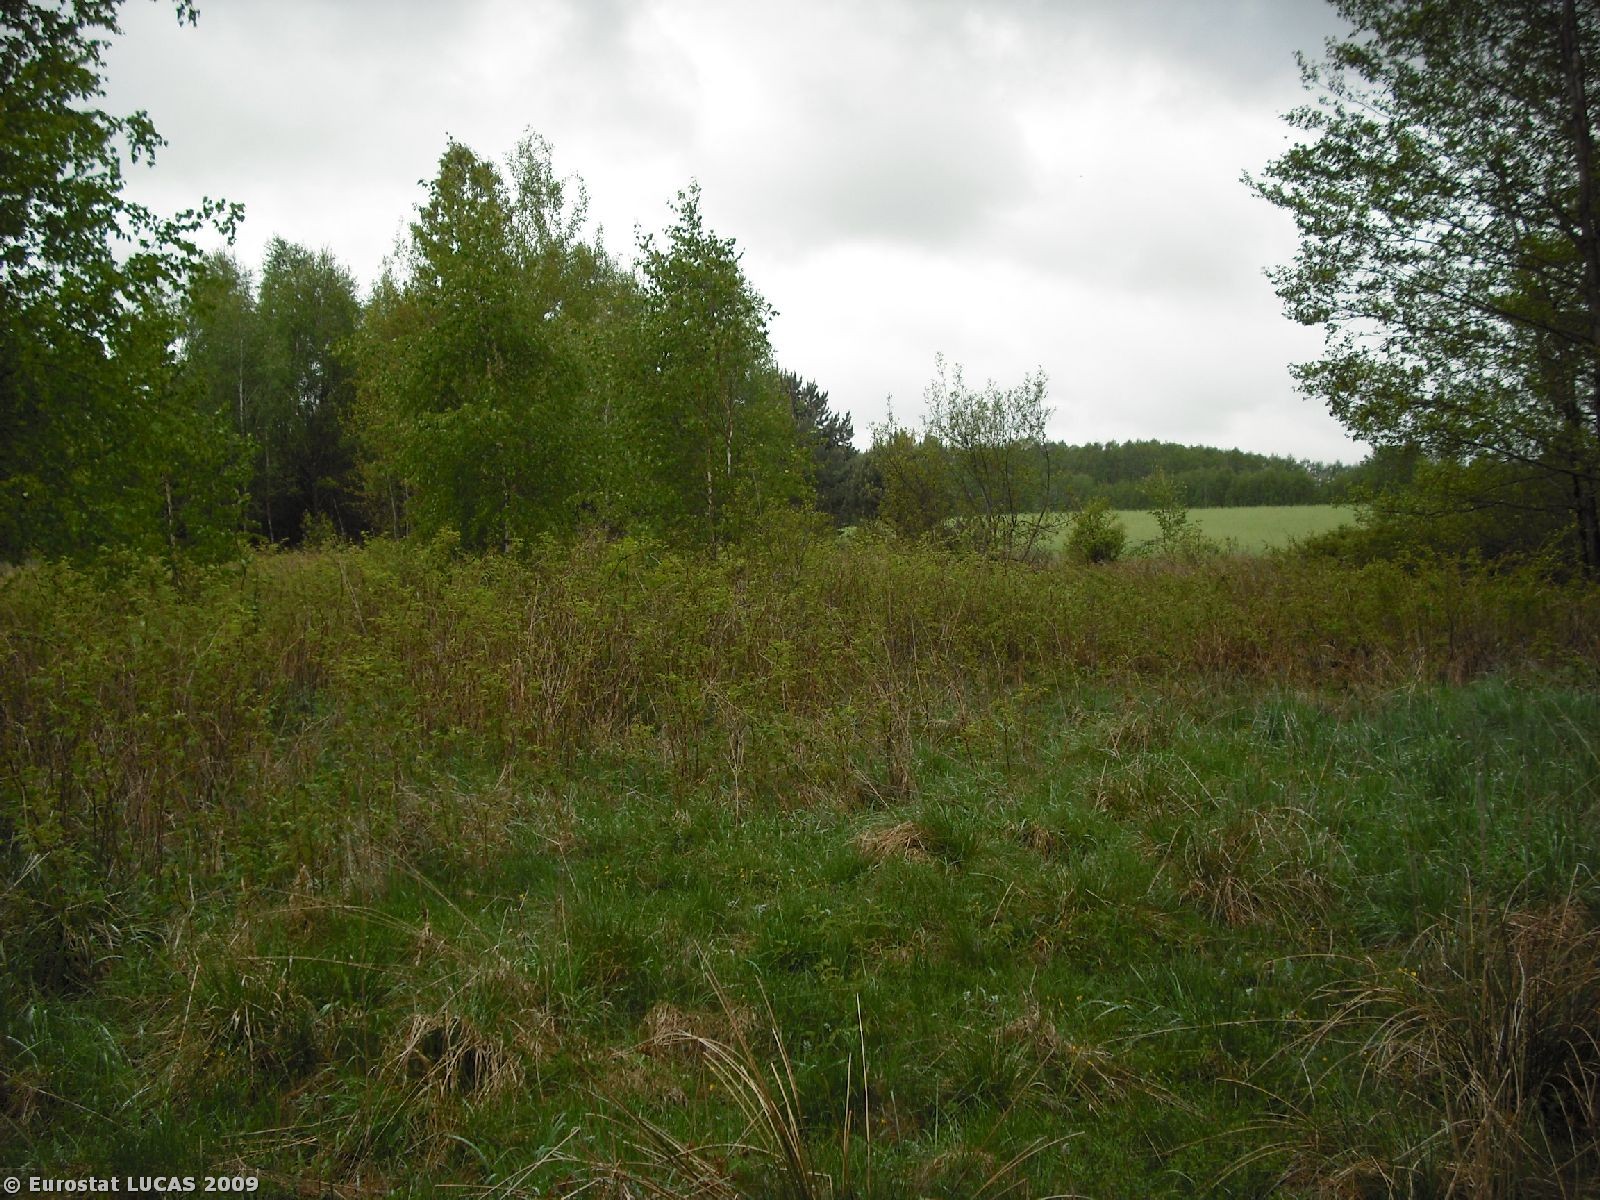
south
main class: Grassland
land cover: Grassland with sparse tree/shrub cover
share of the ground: > 75 %
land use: Unused
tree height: < 5 m
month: May
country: PL
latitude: 52.9752
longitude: 23.2893
